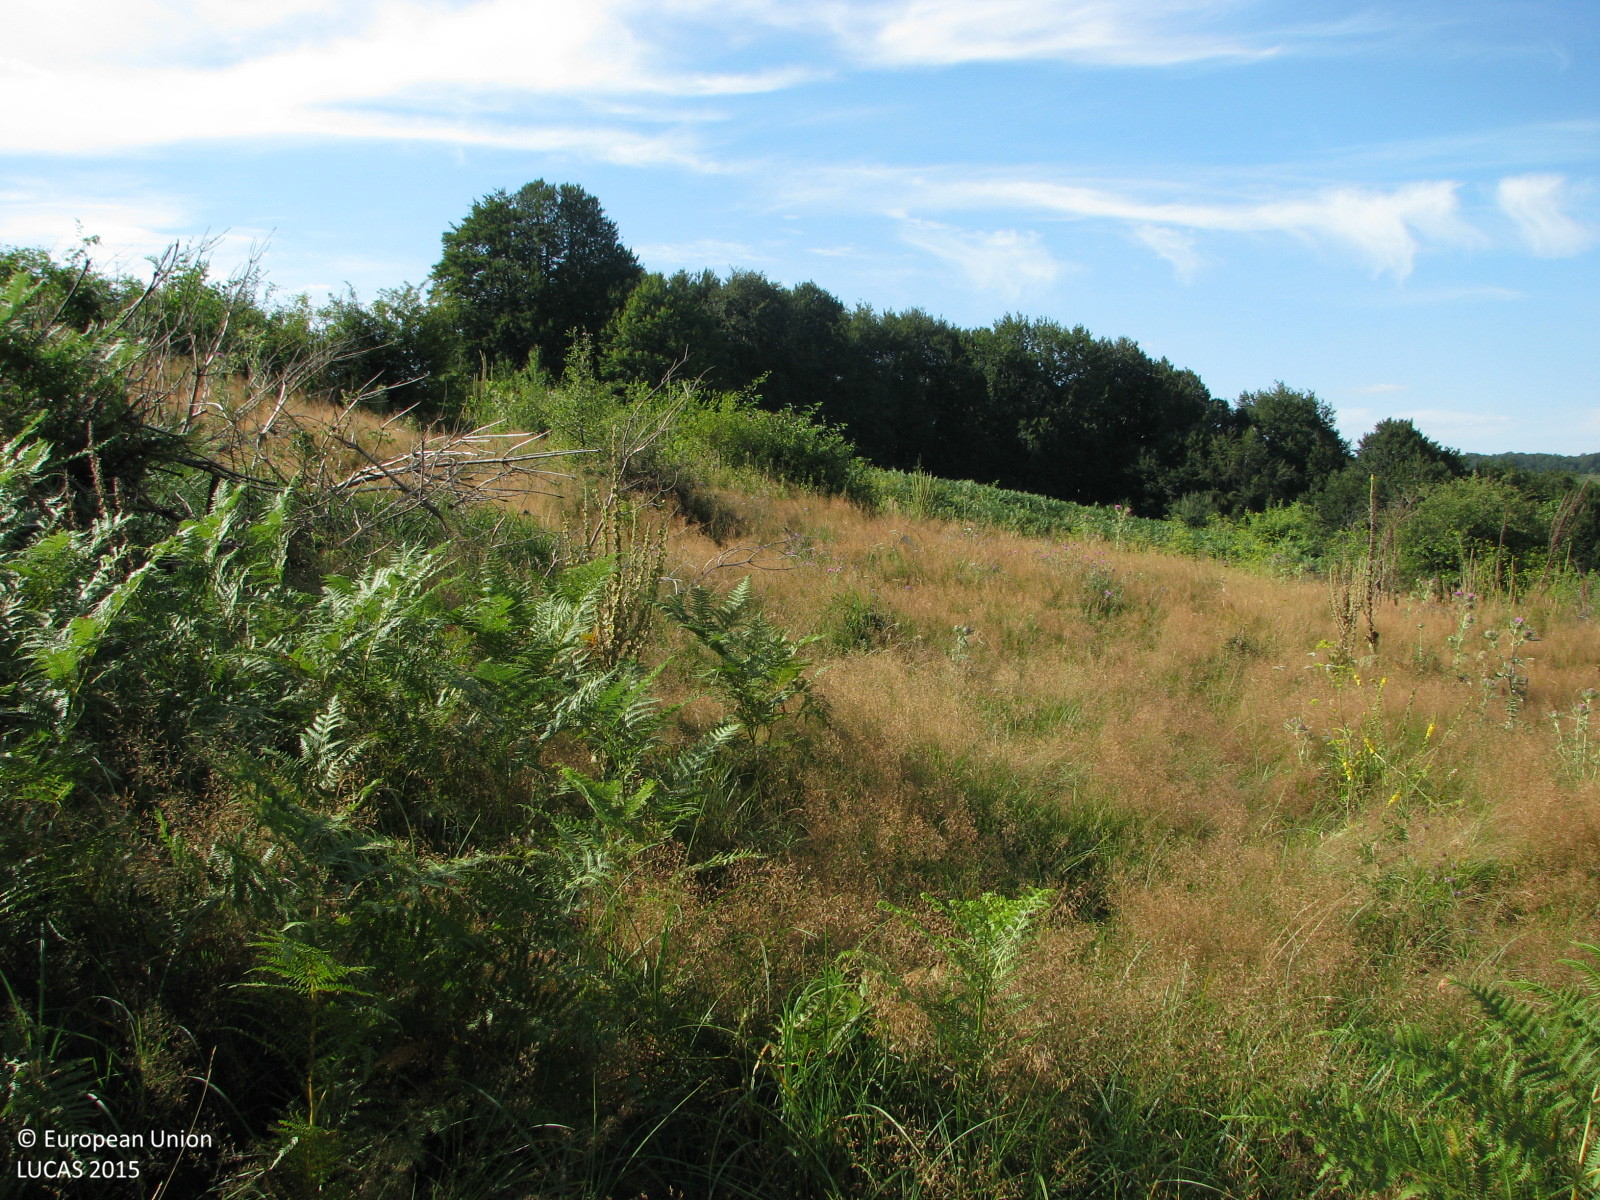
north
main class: Shrubland
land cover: Shrubland with sparse tree cover
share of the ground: > 75 %
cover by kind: shrubs 75 %, herbaceous plants 20 %, coniferous forest trees 5 %
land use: Semi-natural and natural areas not in use
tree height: > 5 m
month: August
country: BG
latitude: 42.8032
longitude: 26.2430
